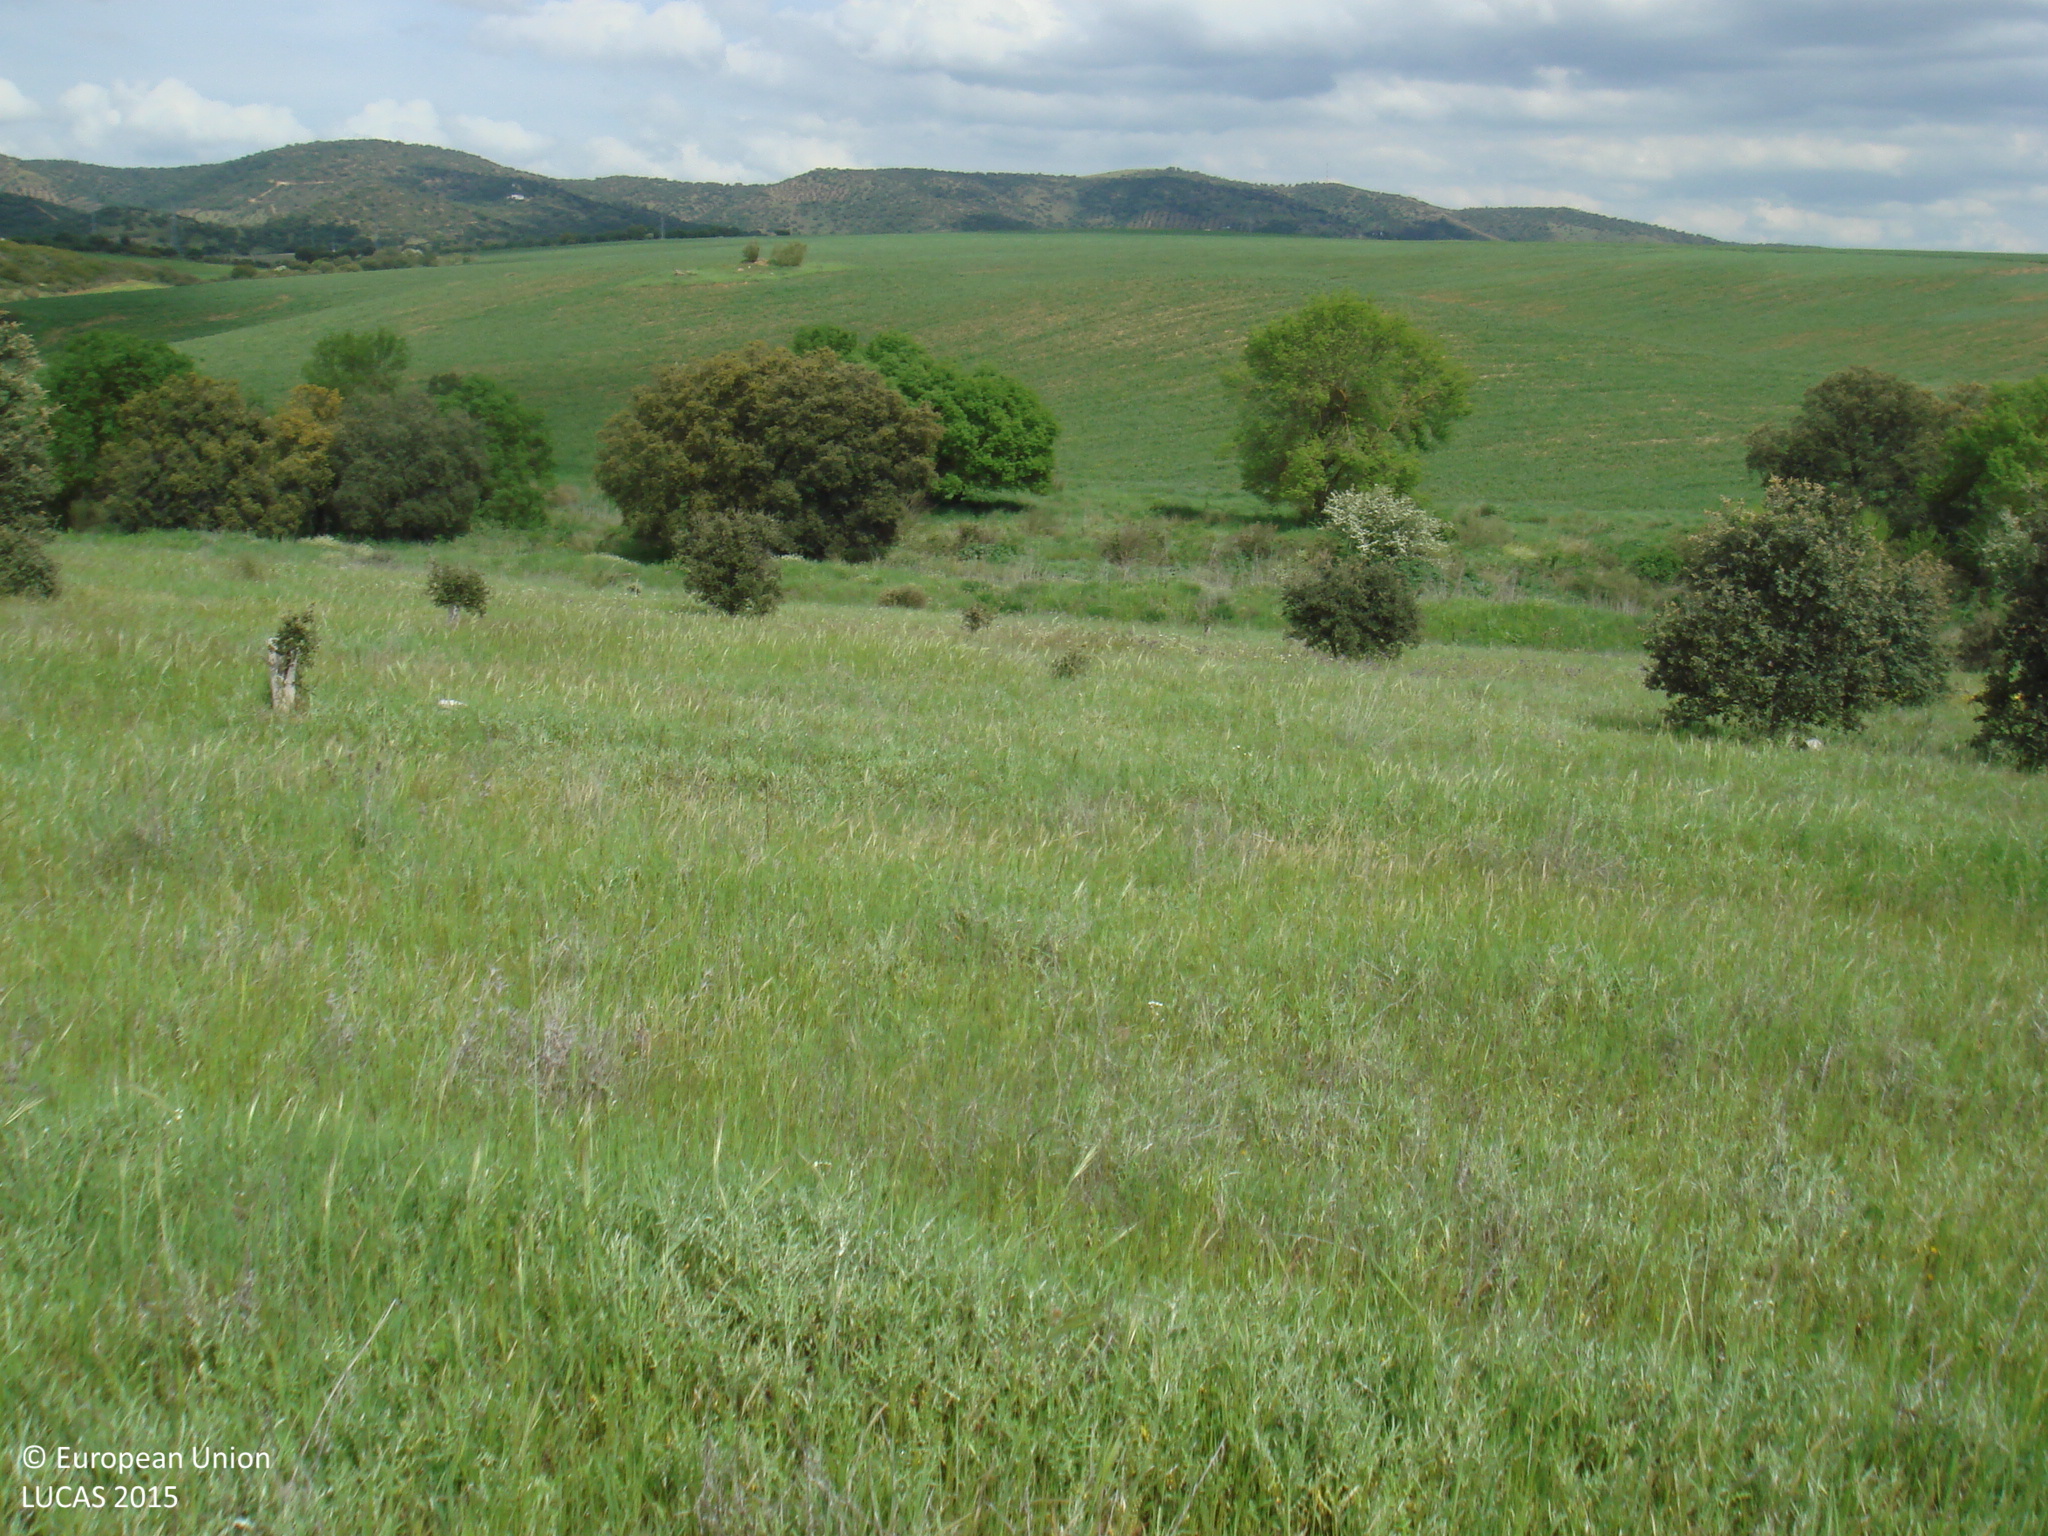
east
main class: Grassland
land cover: Grassland without tree/shrub cover
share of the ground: > 75 %
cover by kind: herbaceous plants 95 %, shrubs 5 %
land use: Agriculture (excluding fallow land and kitchen gardens)
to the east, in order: Grassland without tree/shrub cover; Tracks; Grassland with sparse tree/shrub cover; Other bare soil; Fences; Broadleaved woodland; Rivers and streams; Broadleaved woodland; Fences; Dry pulses
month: April
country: ES
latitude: 38.1965
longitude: -5.0618
